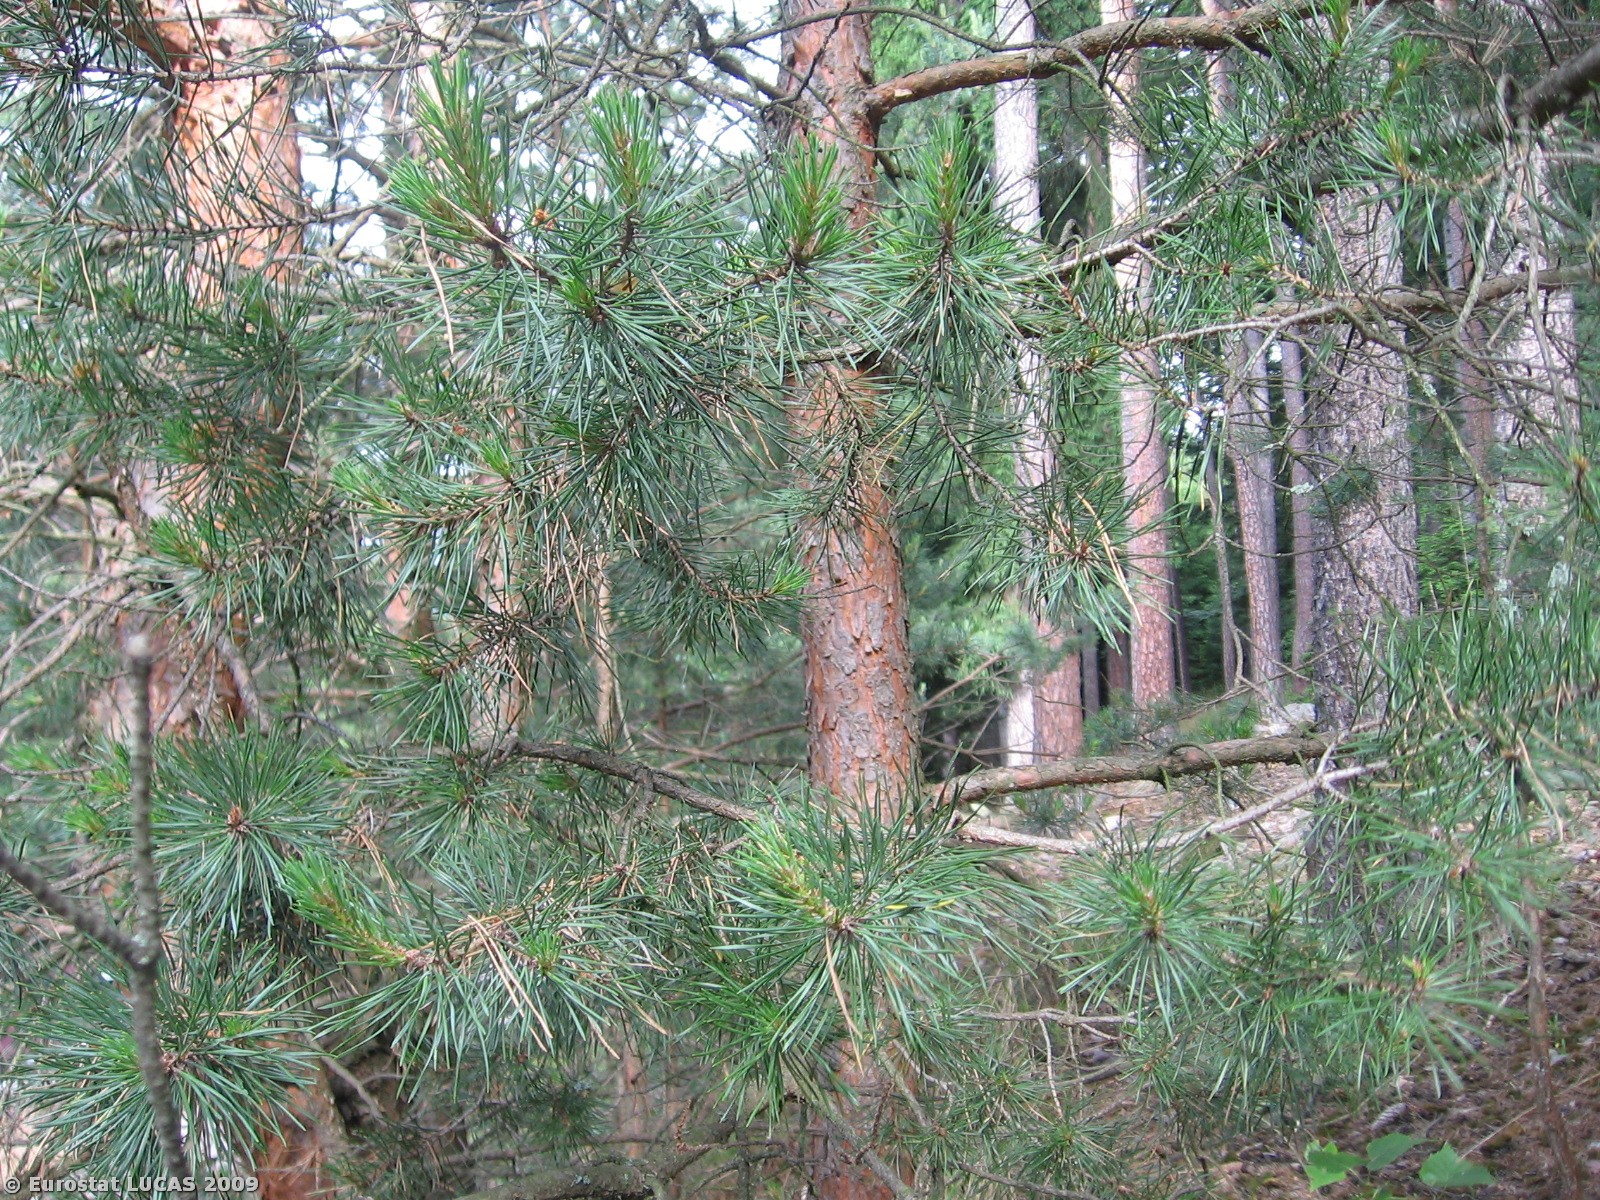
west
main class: Woodland
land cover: Coniferous woodland
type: hemiboreal forest and nemoral coniferous forest and mixed broadleaved-coniferous forest
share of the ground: > 75 %
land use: Forestry
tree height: > 5 m
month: June
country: CZ
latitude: 49.1289
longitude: 13.8513
